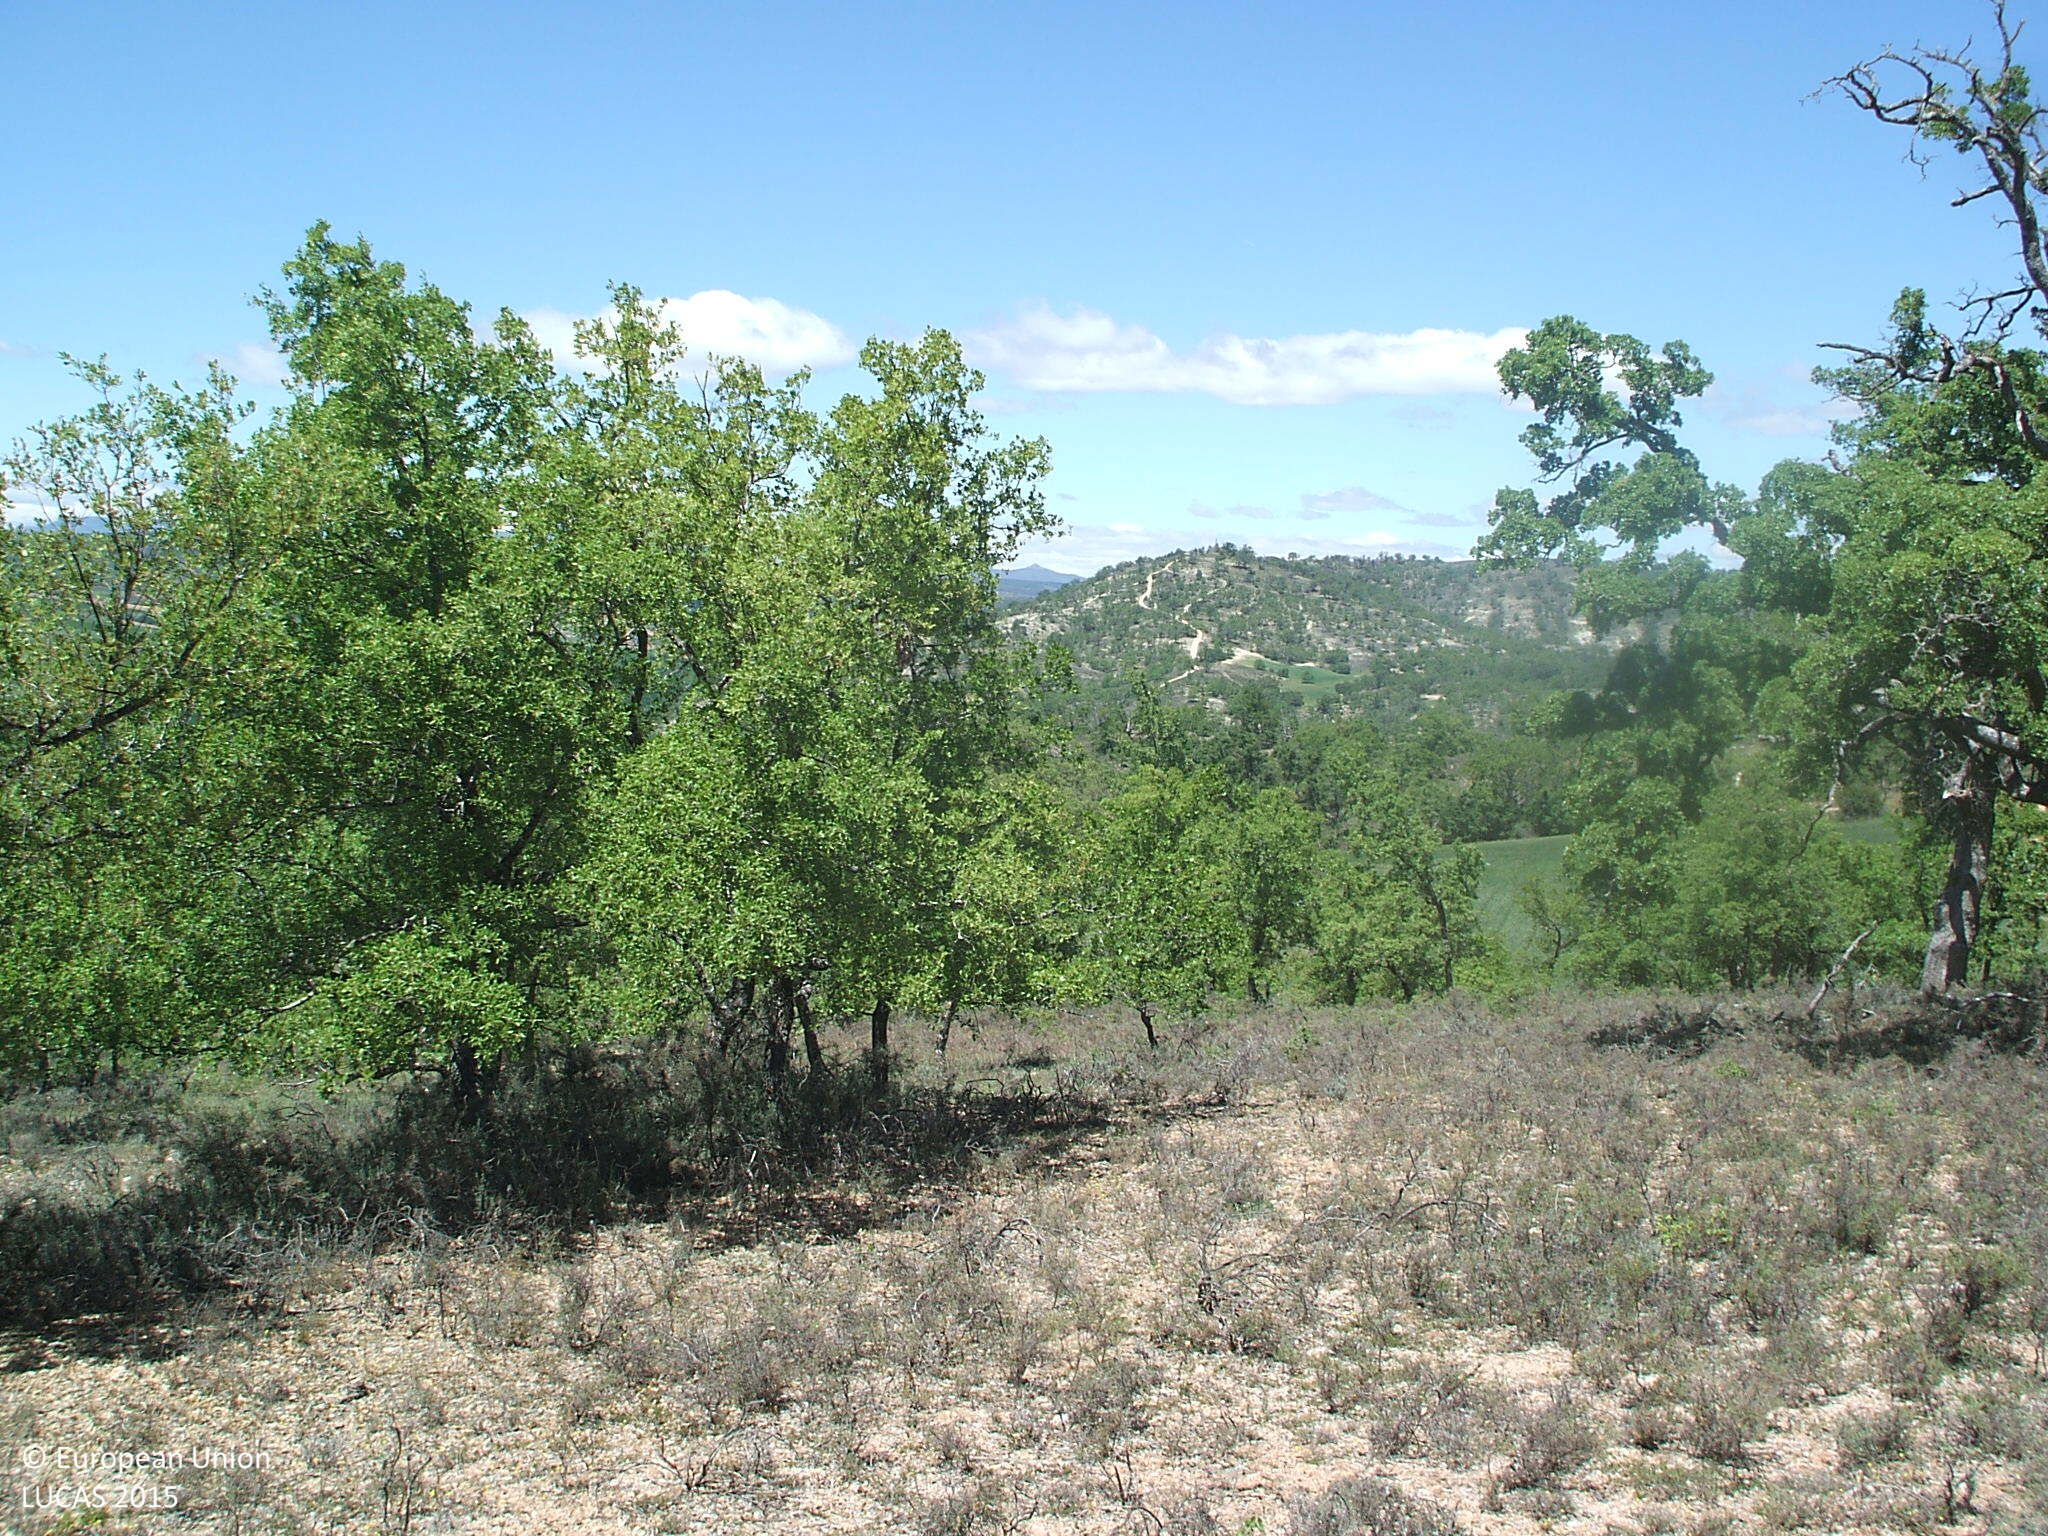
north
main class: Woodland
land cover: Broadleaved woodland
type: broadleaved evergreen forest
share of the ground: 25 - 50 %
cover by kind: broadleaved forest trees 30 %, unconsolidated bare surface 30 %, shrubs 20 %, herbaceous plants 20 %
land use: Semi-natural and natural areas not in use
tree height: > 5 m
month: May
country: ES
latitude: 40.9808
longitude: -2.9300
